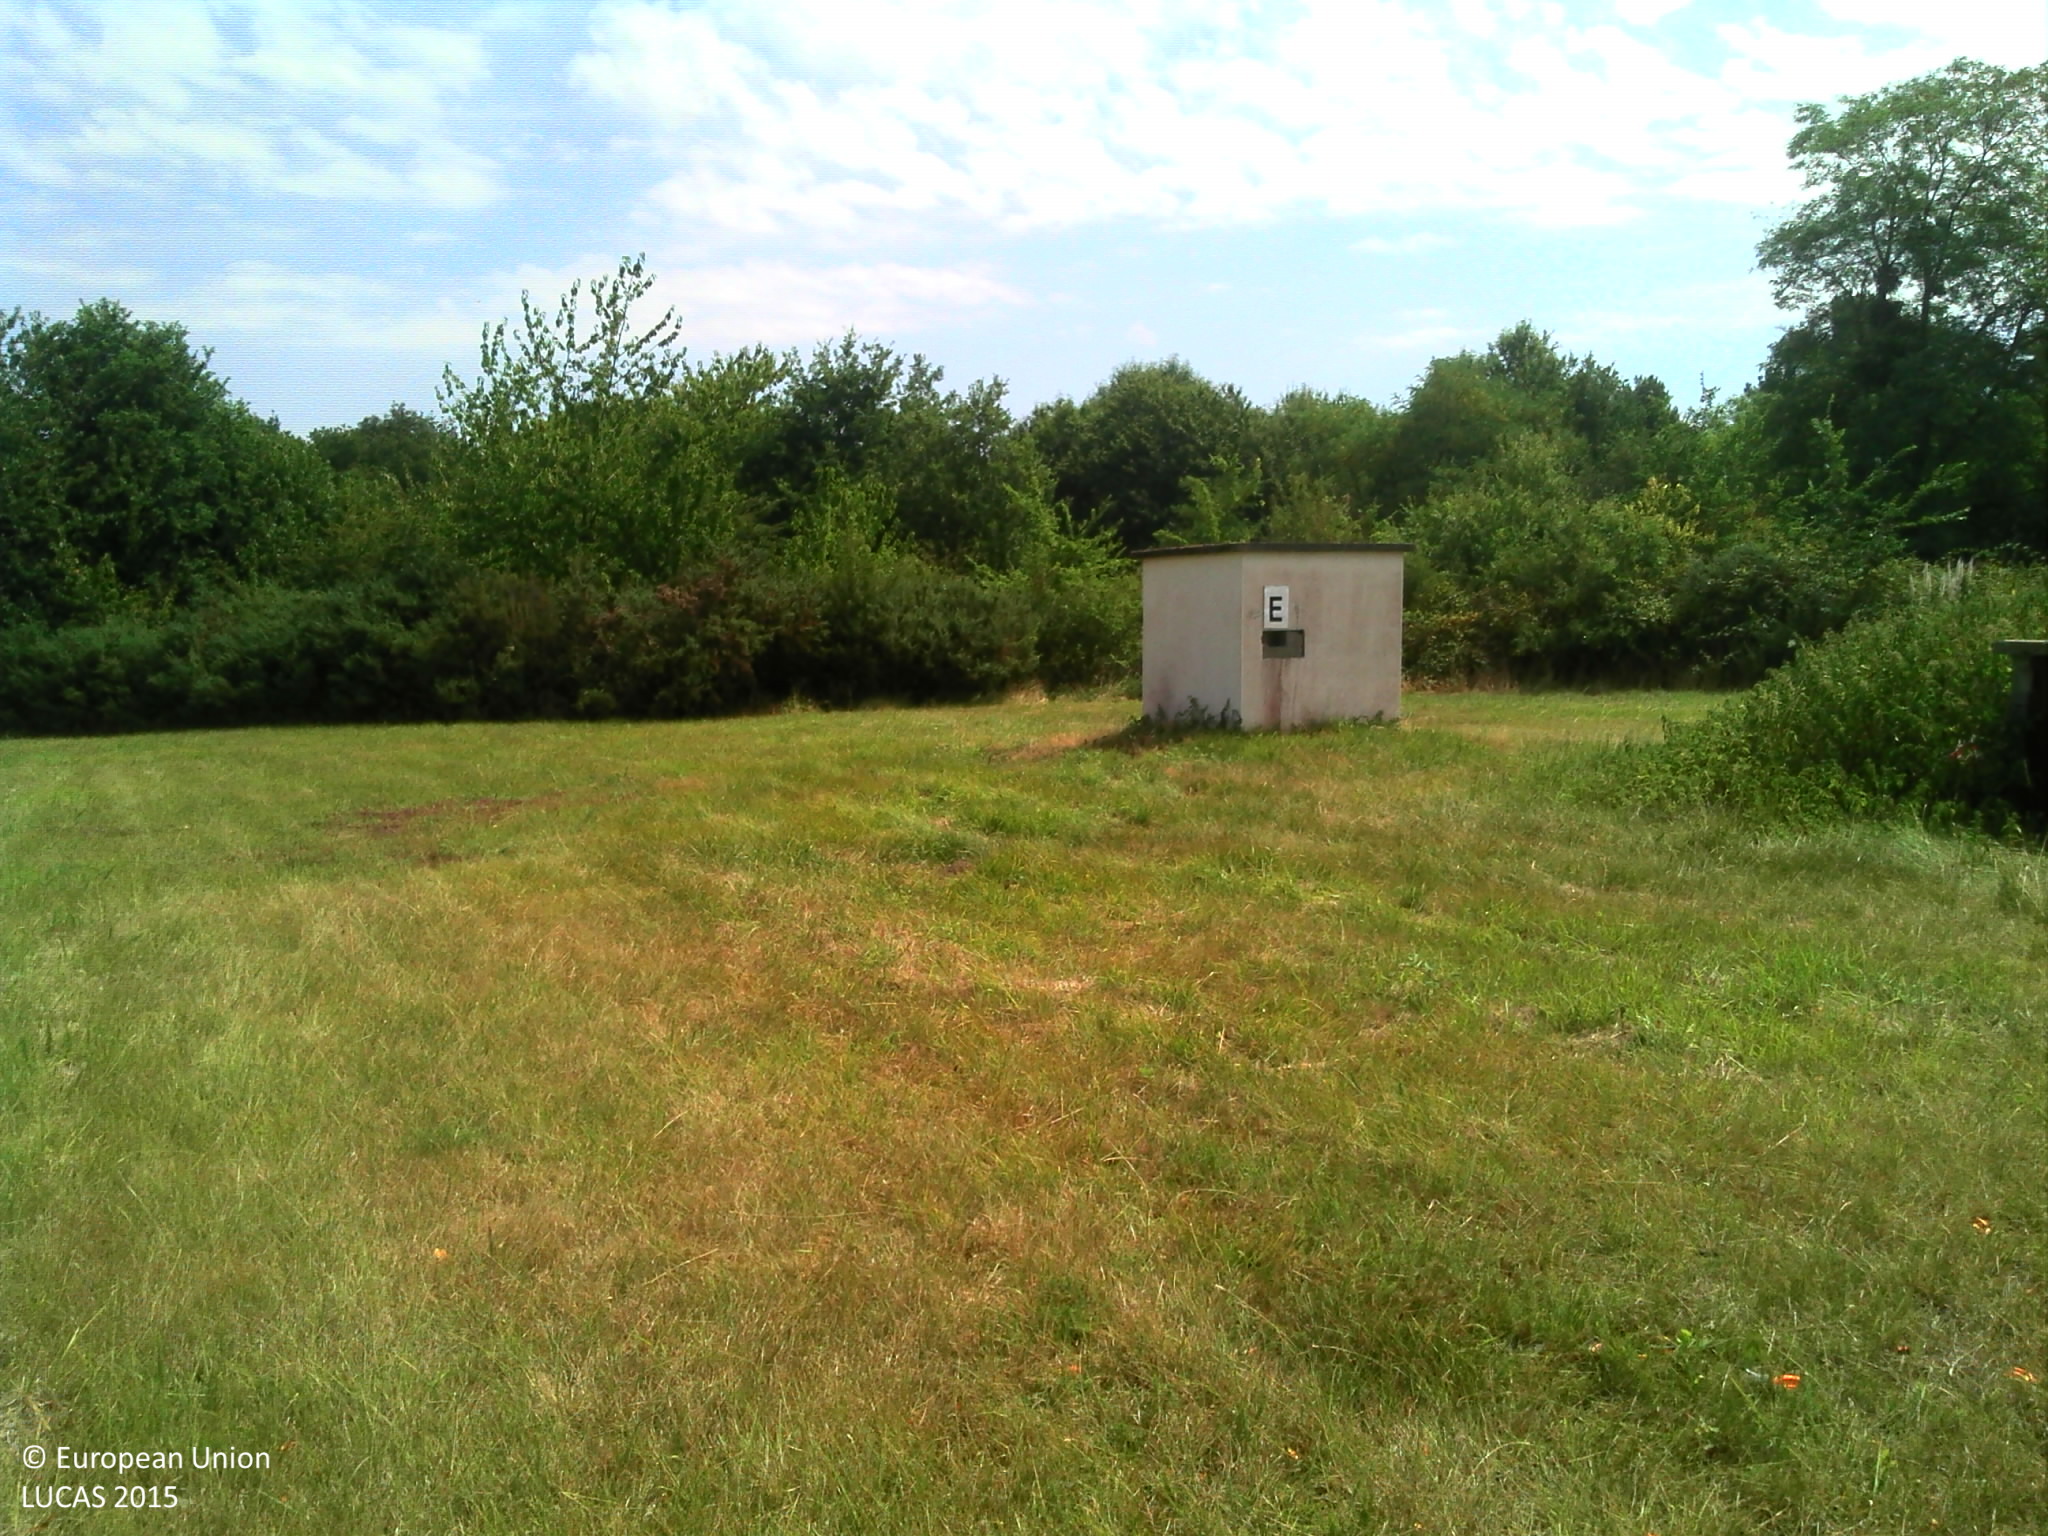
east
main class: Grassland
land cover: Grassland without tree/shrub cover
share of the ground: > 75 %
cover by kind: herbaceous plants 95 %, shrubs 5 %
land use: Sport
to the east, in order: Grassland without tree/shrub cover; Broadleaved woodland; Grass margins; Tracks; Grass margins; Broadleaved woodland; Tracks; Broadleaved woodland; Spontaneously vegetated surfaces
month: August
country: FR
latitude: 47.1495
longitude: 0.1785
